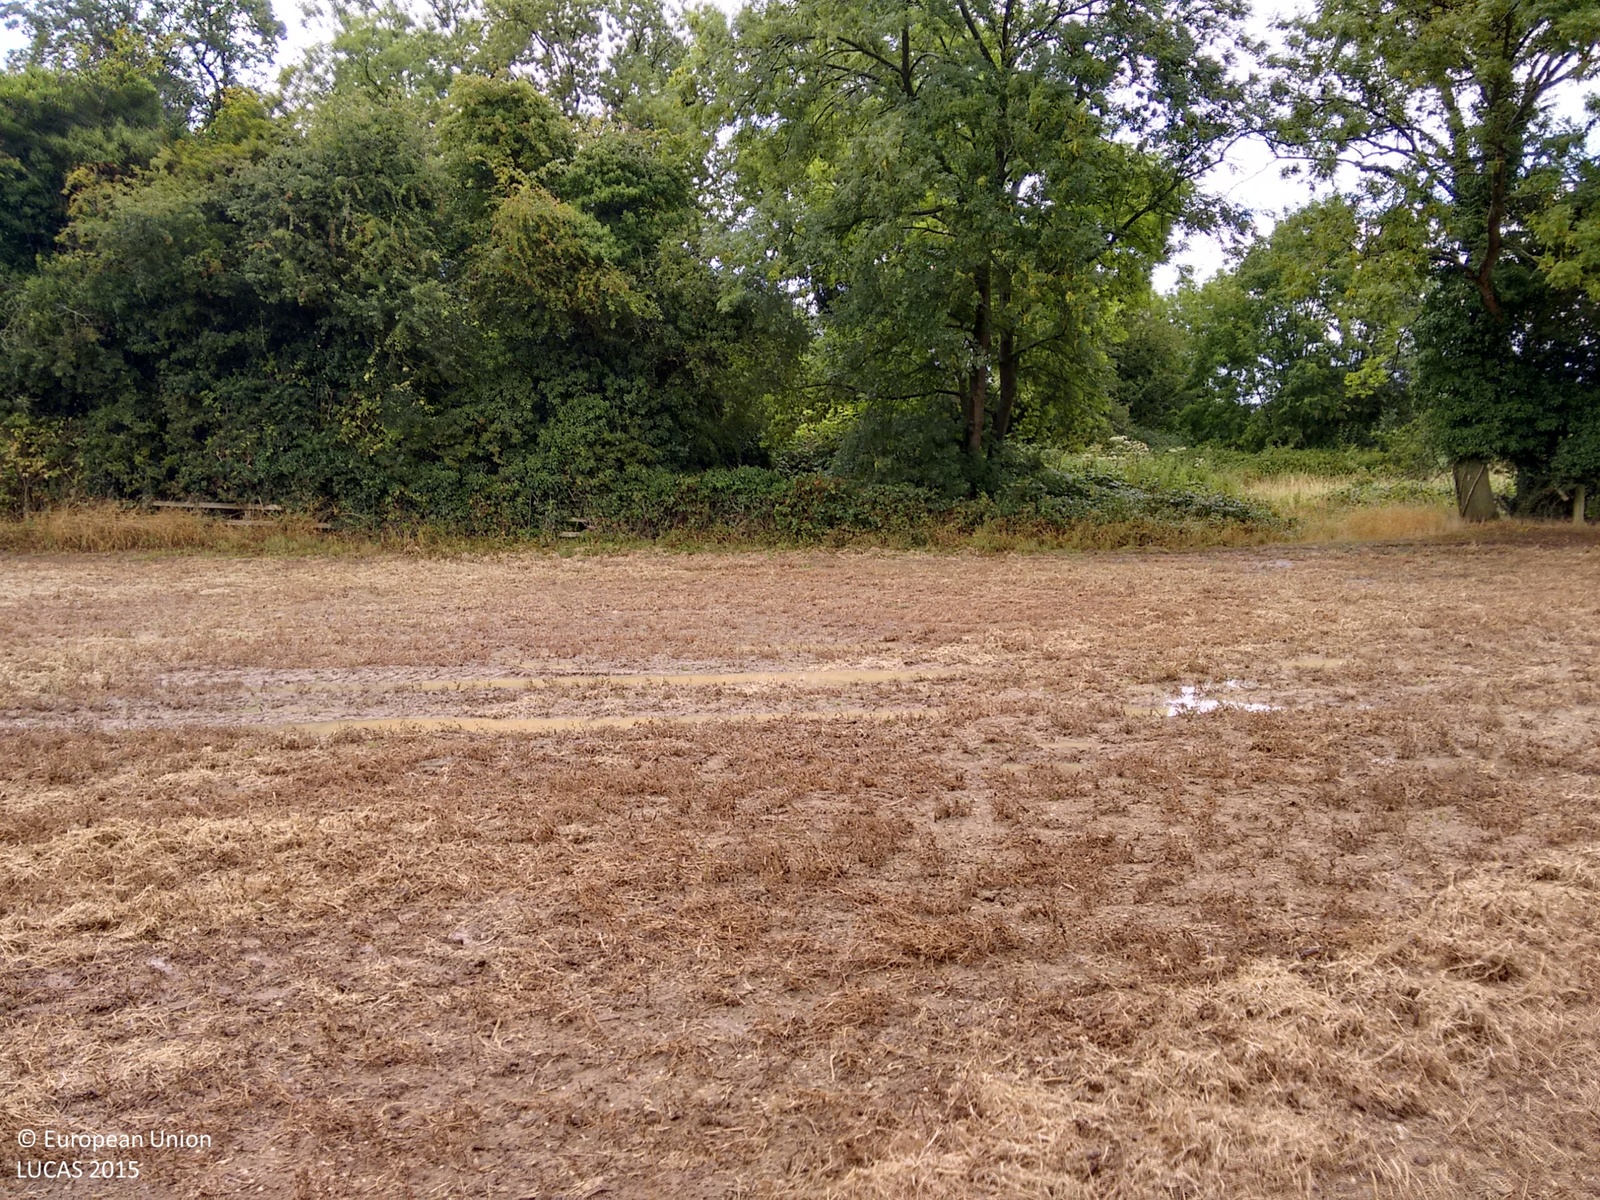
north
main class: Cropland
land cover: Dry pulses
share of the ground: > 75 %
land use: Agriculture (excluding fallow land and kitchen gardens)
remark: Harvested field
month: September
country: GB
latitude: 52.7662
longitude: -1.4470
